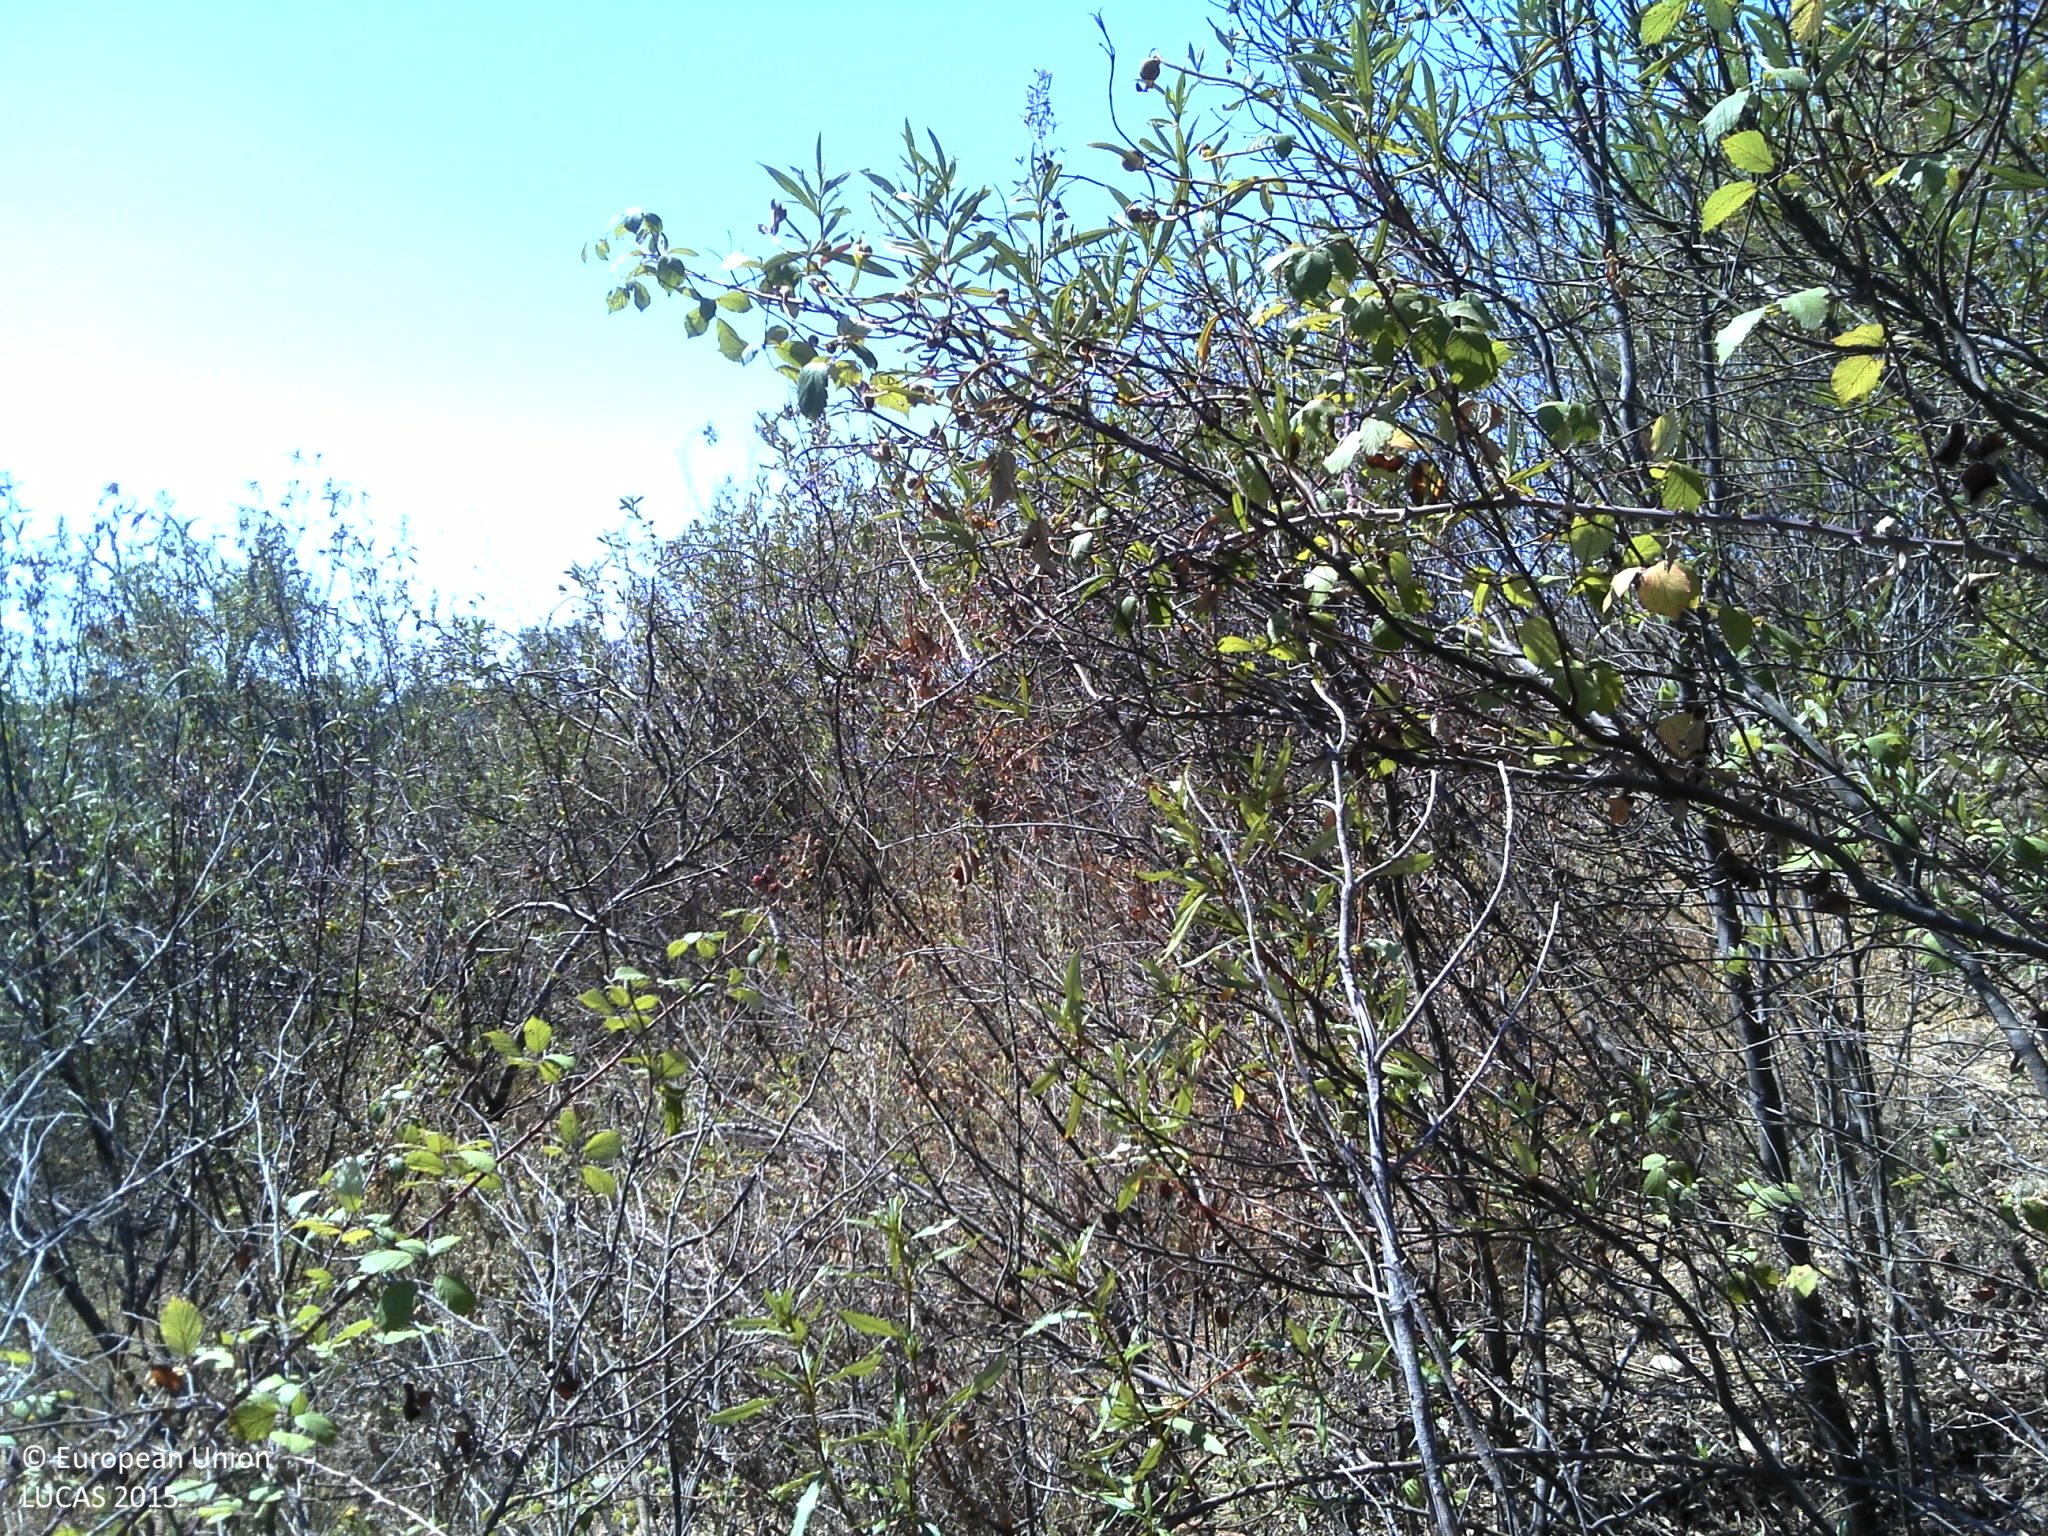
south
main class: Woodland
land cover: Pine dominated mixed woodland
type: coniferous forest of the mediterranean region
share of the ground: 10 - 25 %
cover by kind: shrubs 45 %, coniferous forest trees 25 %, unconsolidated bare surface 20 %, broadleaved forest trees 10 %
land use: Forestry
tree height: > 5 m
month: July
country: PT
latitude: 38.4862
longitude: -8.5222
